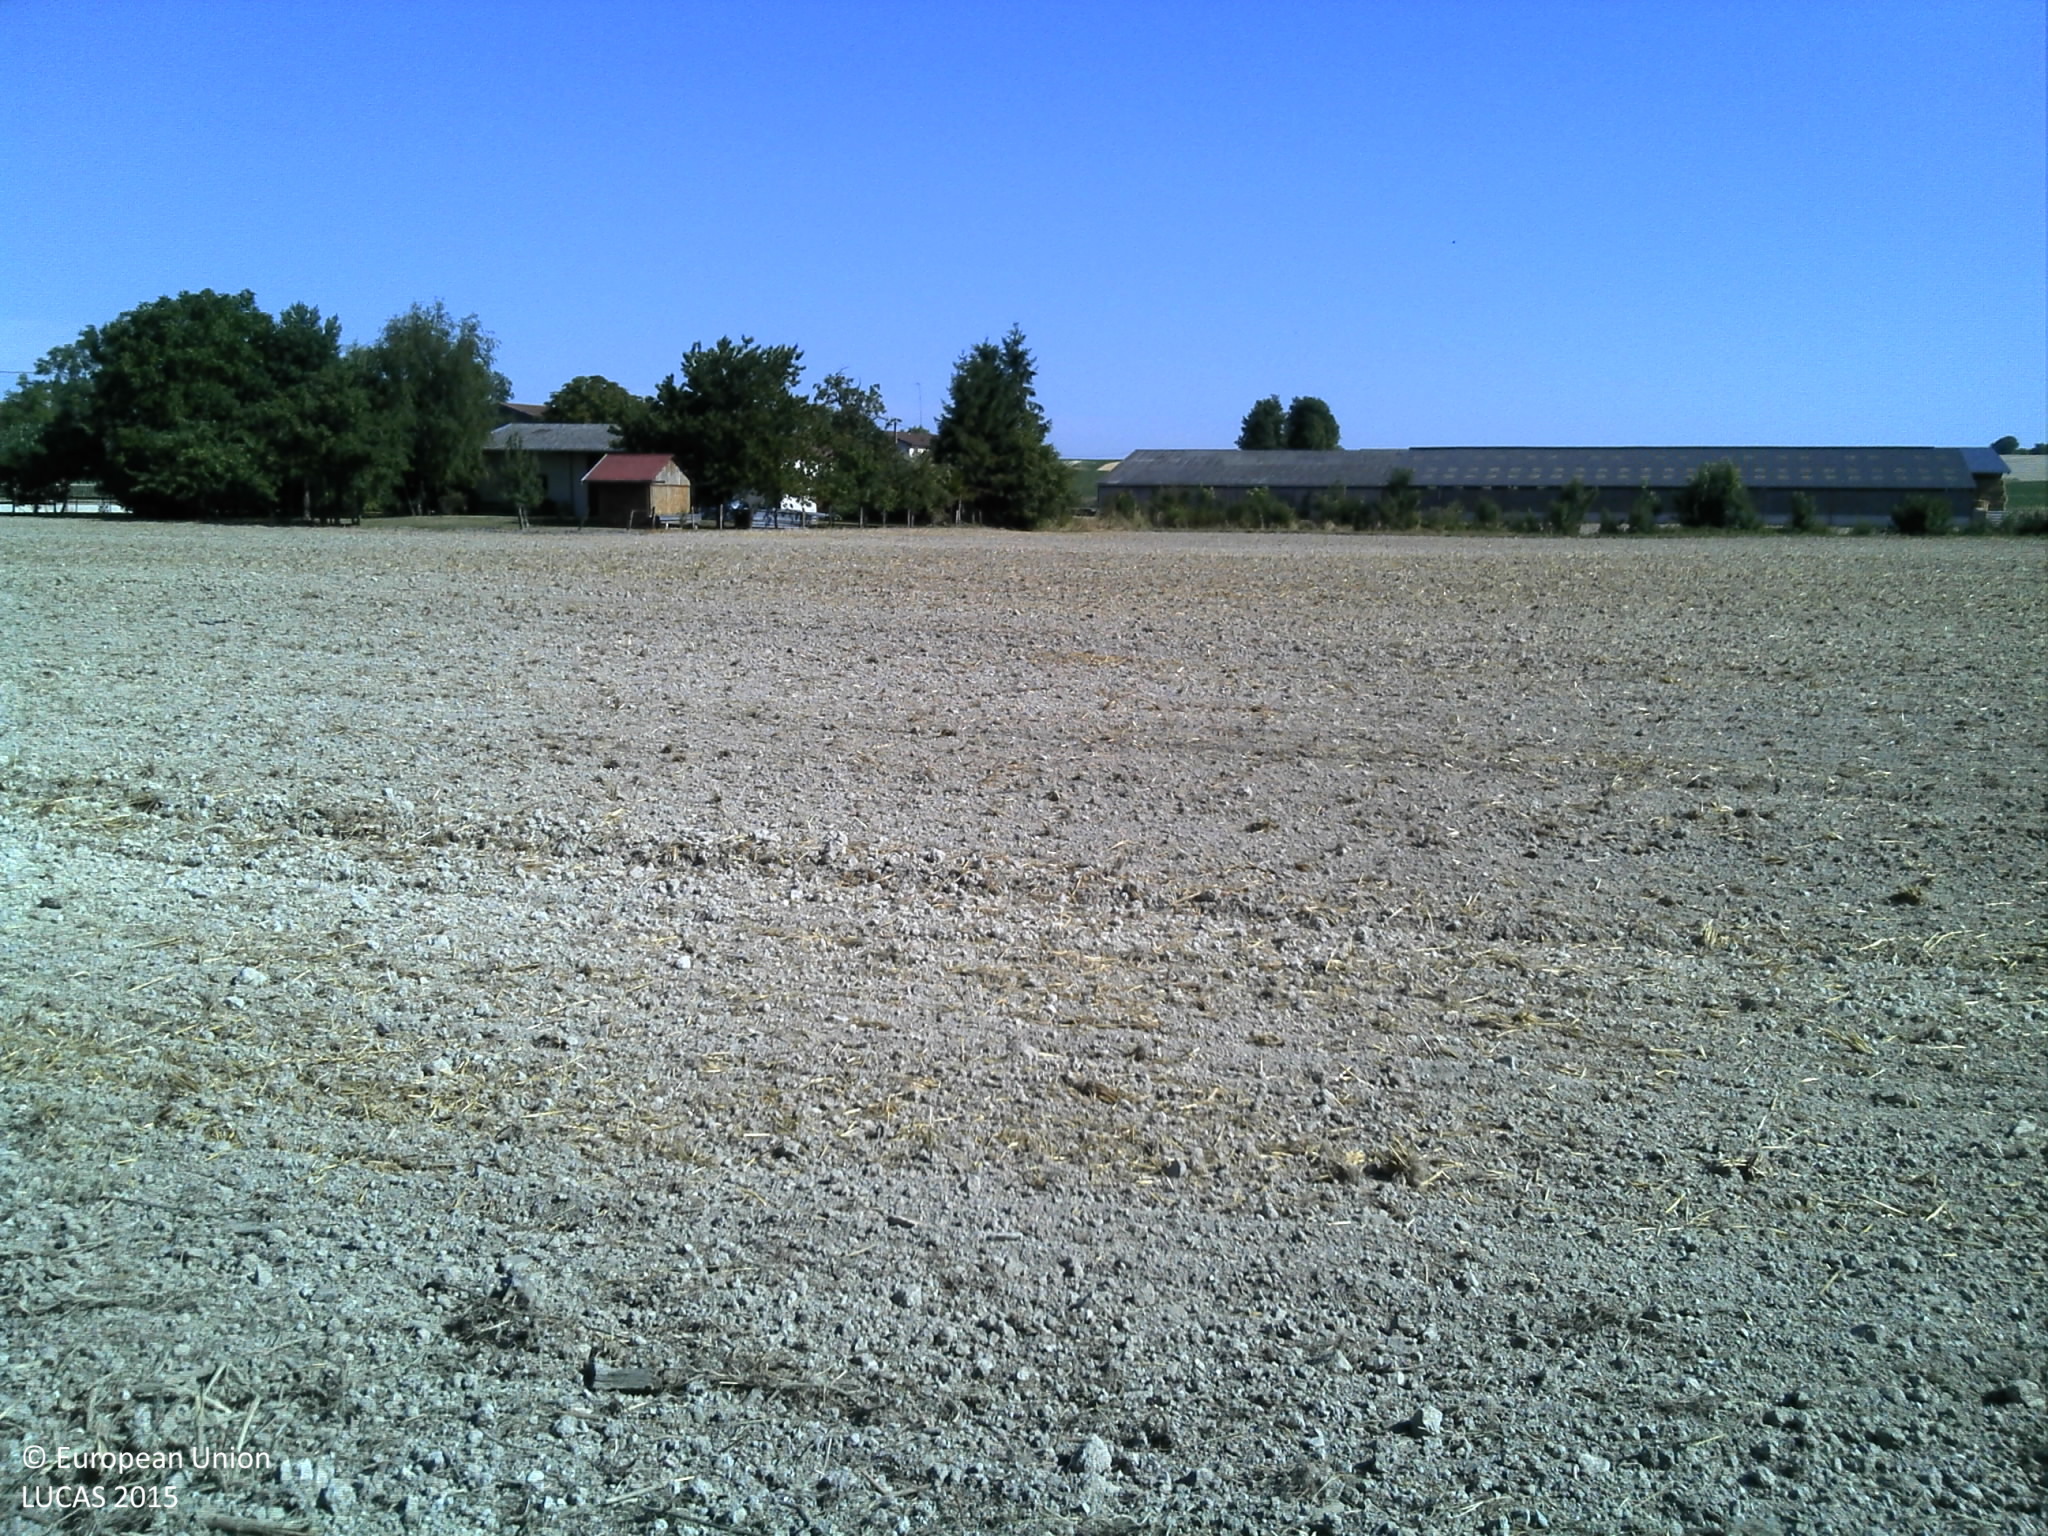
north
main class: Cropland
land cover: Common wheat
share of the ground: > 75 %
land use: Agriculture (excluding fallow land and kitchen gardens)
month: August
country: FR
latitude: 49.1645
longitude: 4.7996
